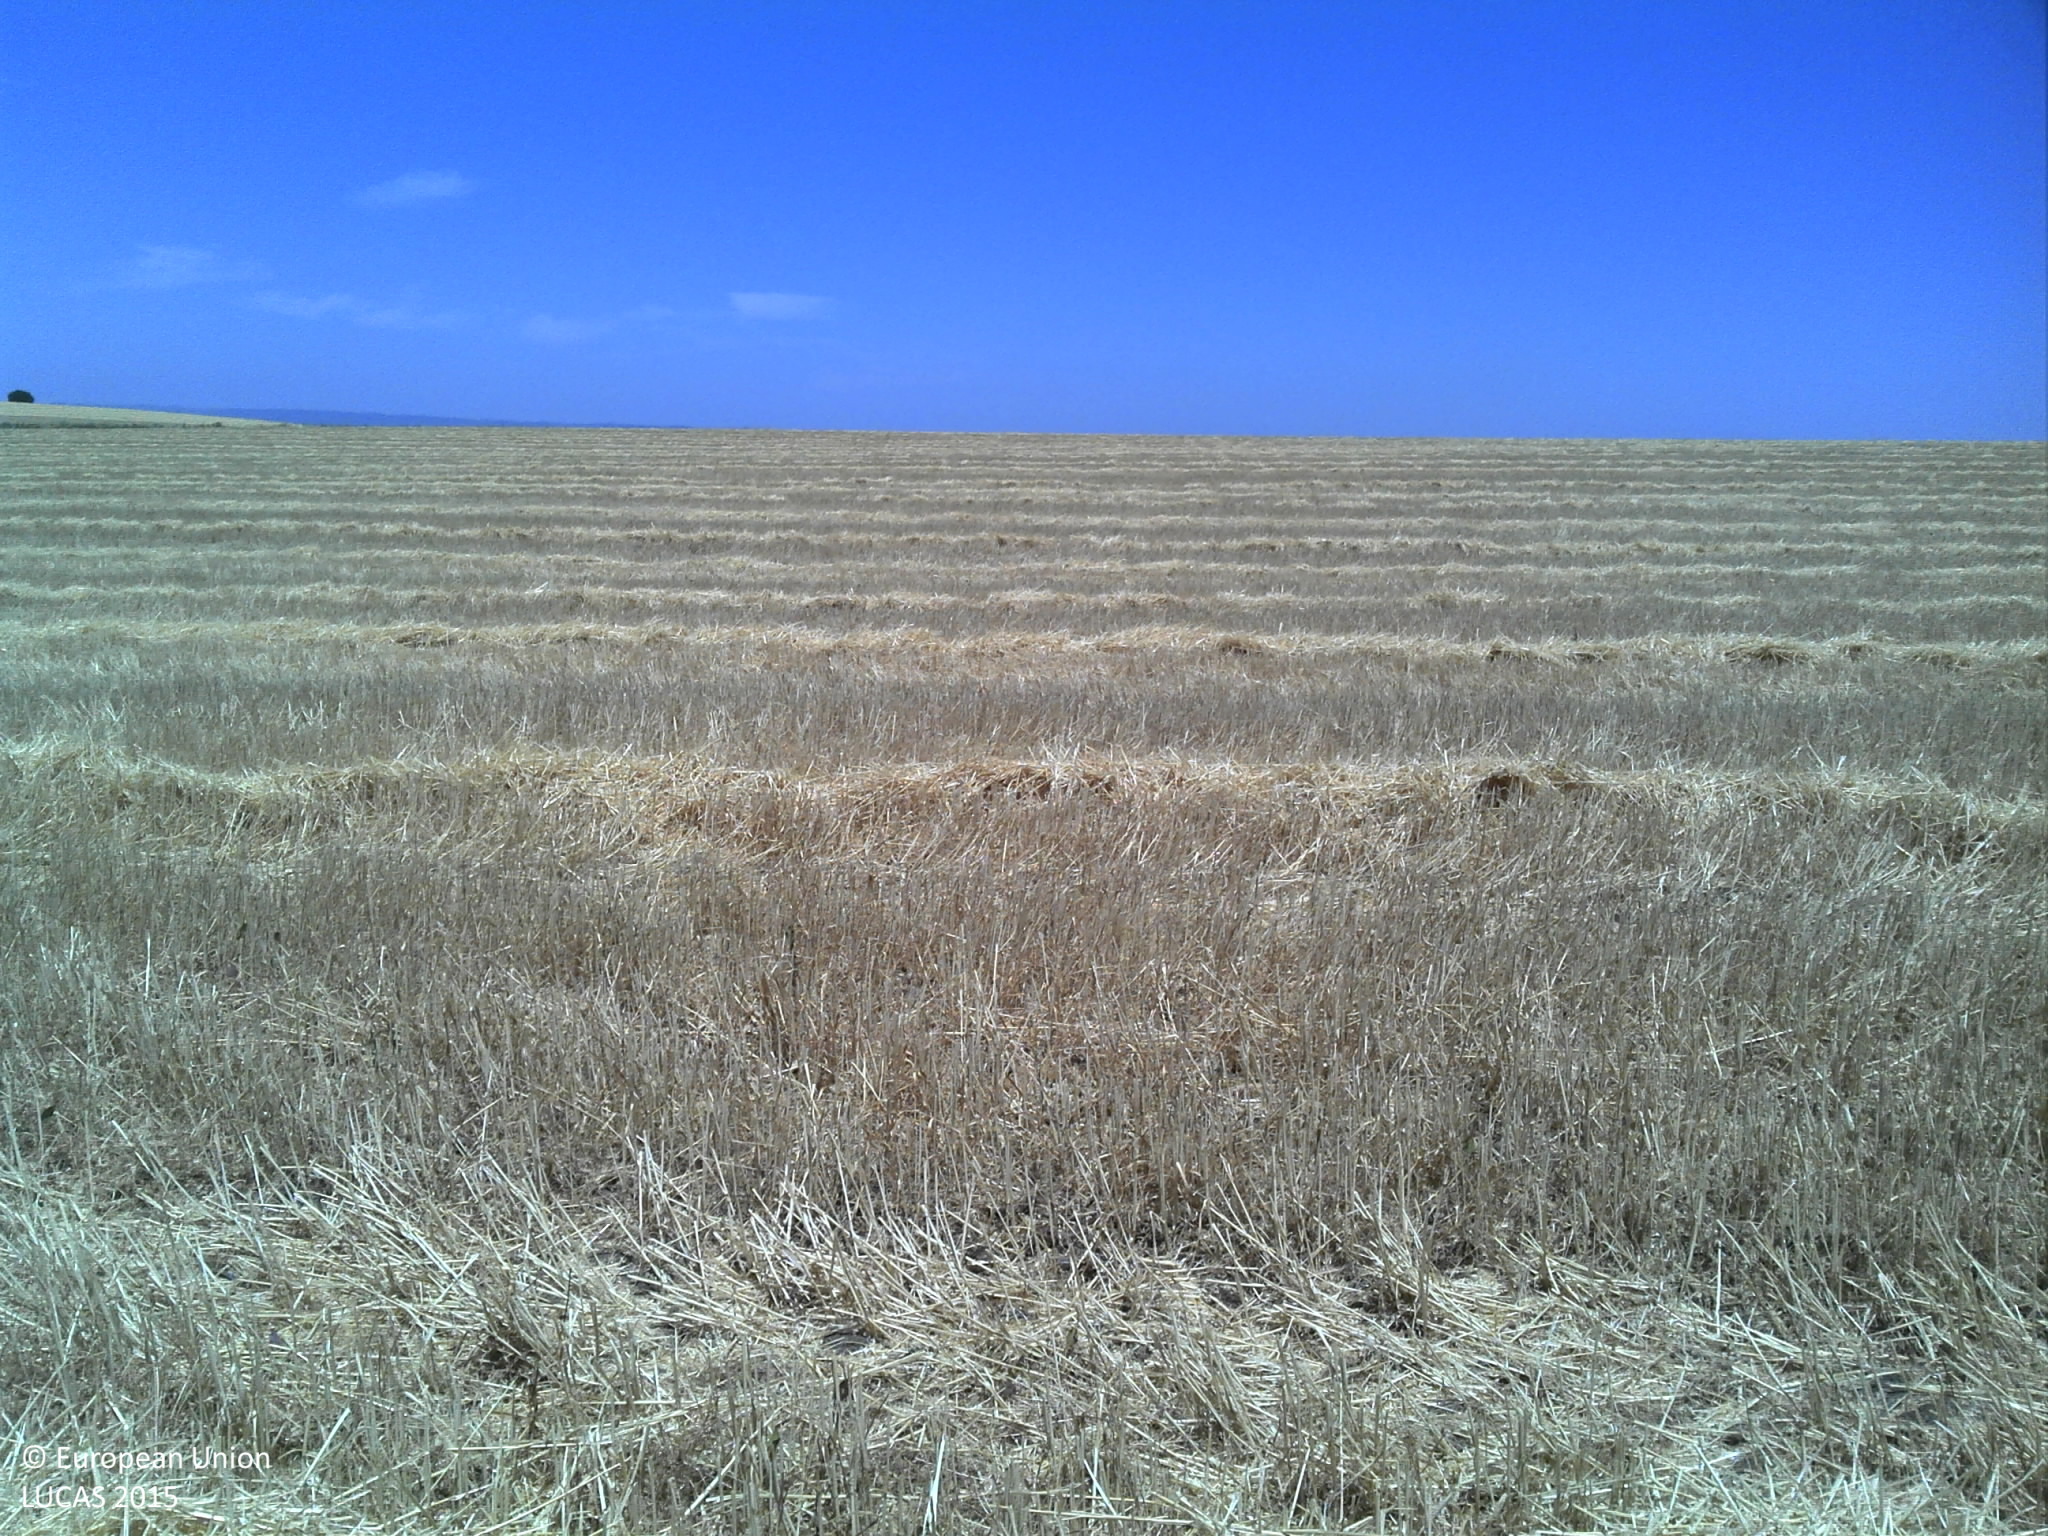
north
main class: Cropland
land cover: Common wheat
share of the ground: > 75 %
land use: Agriculture (excluding fallow land and kitchen gardens)
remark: Harvested field
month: June
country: PT
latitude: 37.9362
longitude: -7.5294
